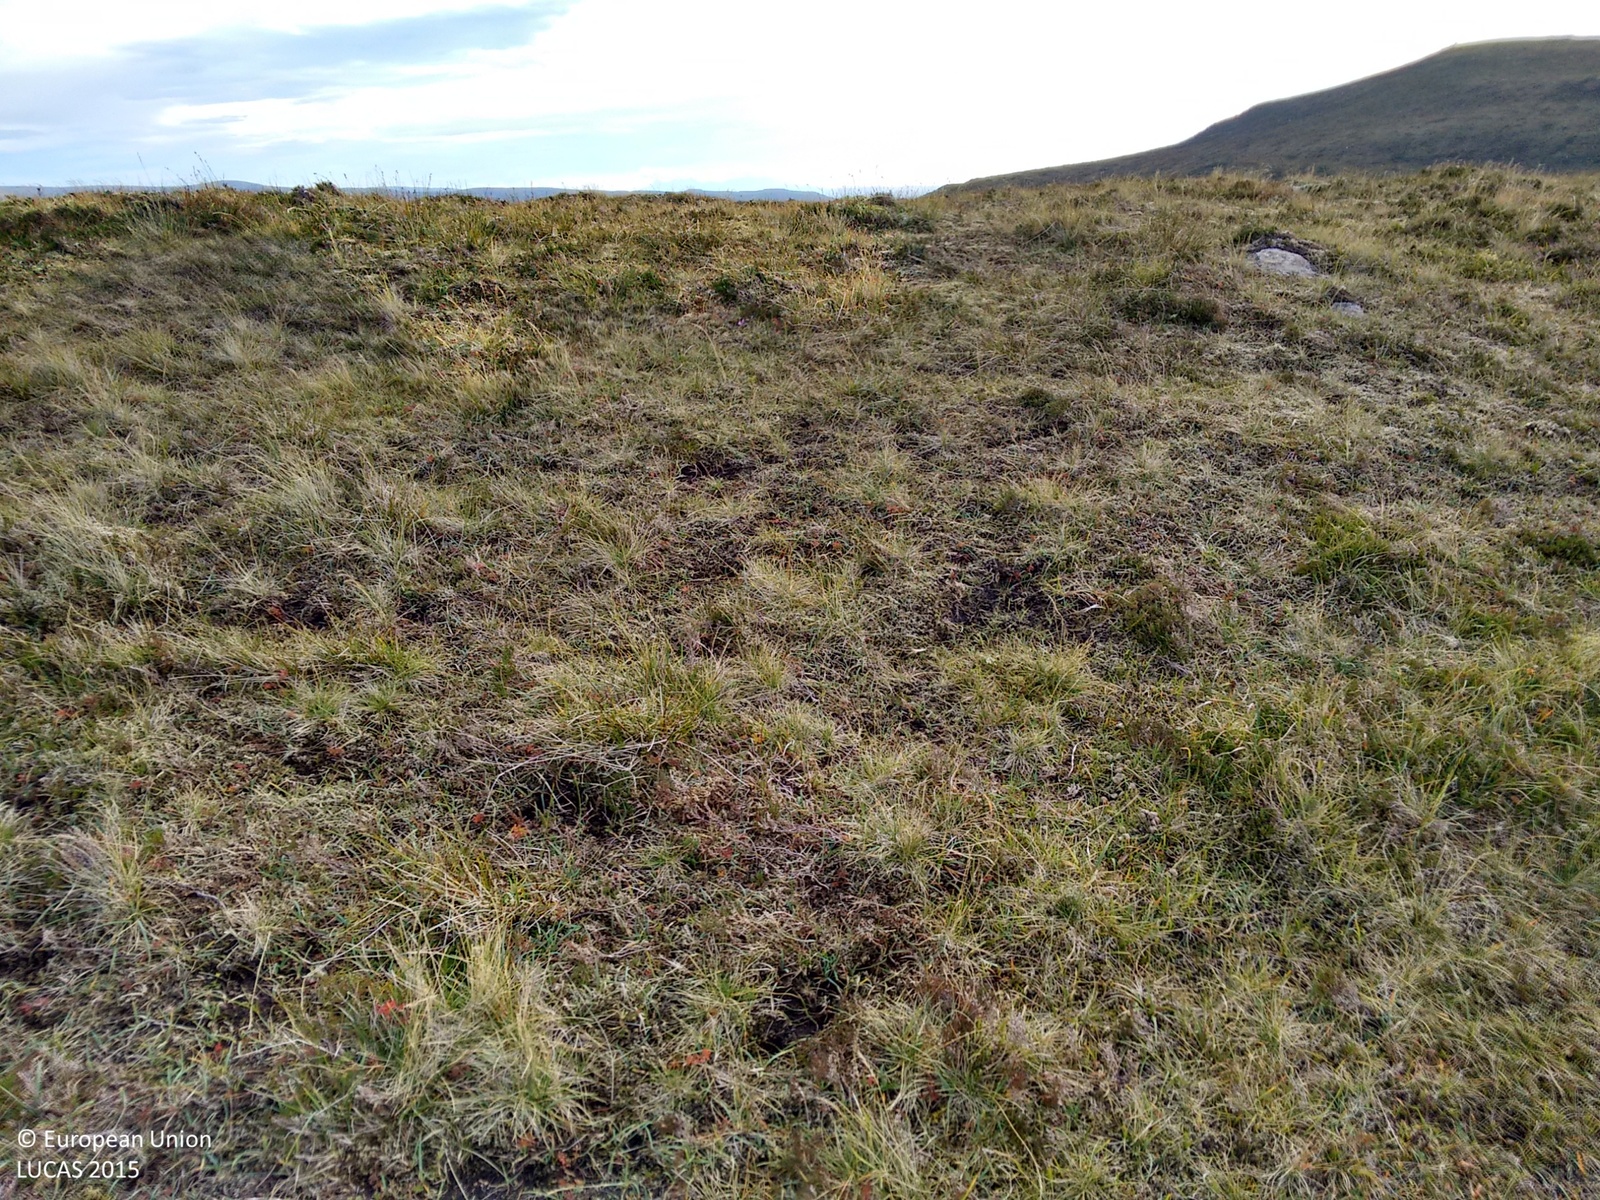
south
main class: Shrubland
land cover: Shrubland without tree cover
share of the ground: > 75 %
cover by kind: shrubs 80 %, herbaceous plants 20 %
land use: Agriculture (excluding fallow land and kitchen gardens)
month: September
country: GB
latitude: 57.6118
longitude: -6.3573
